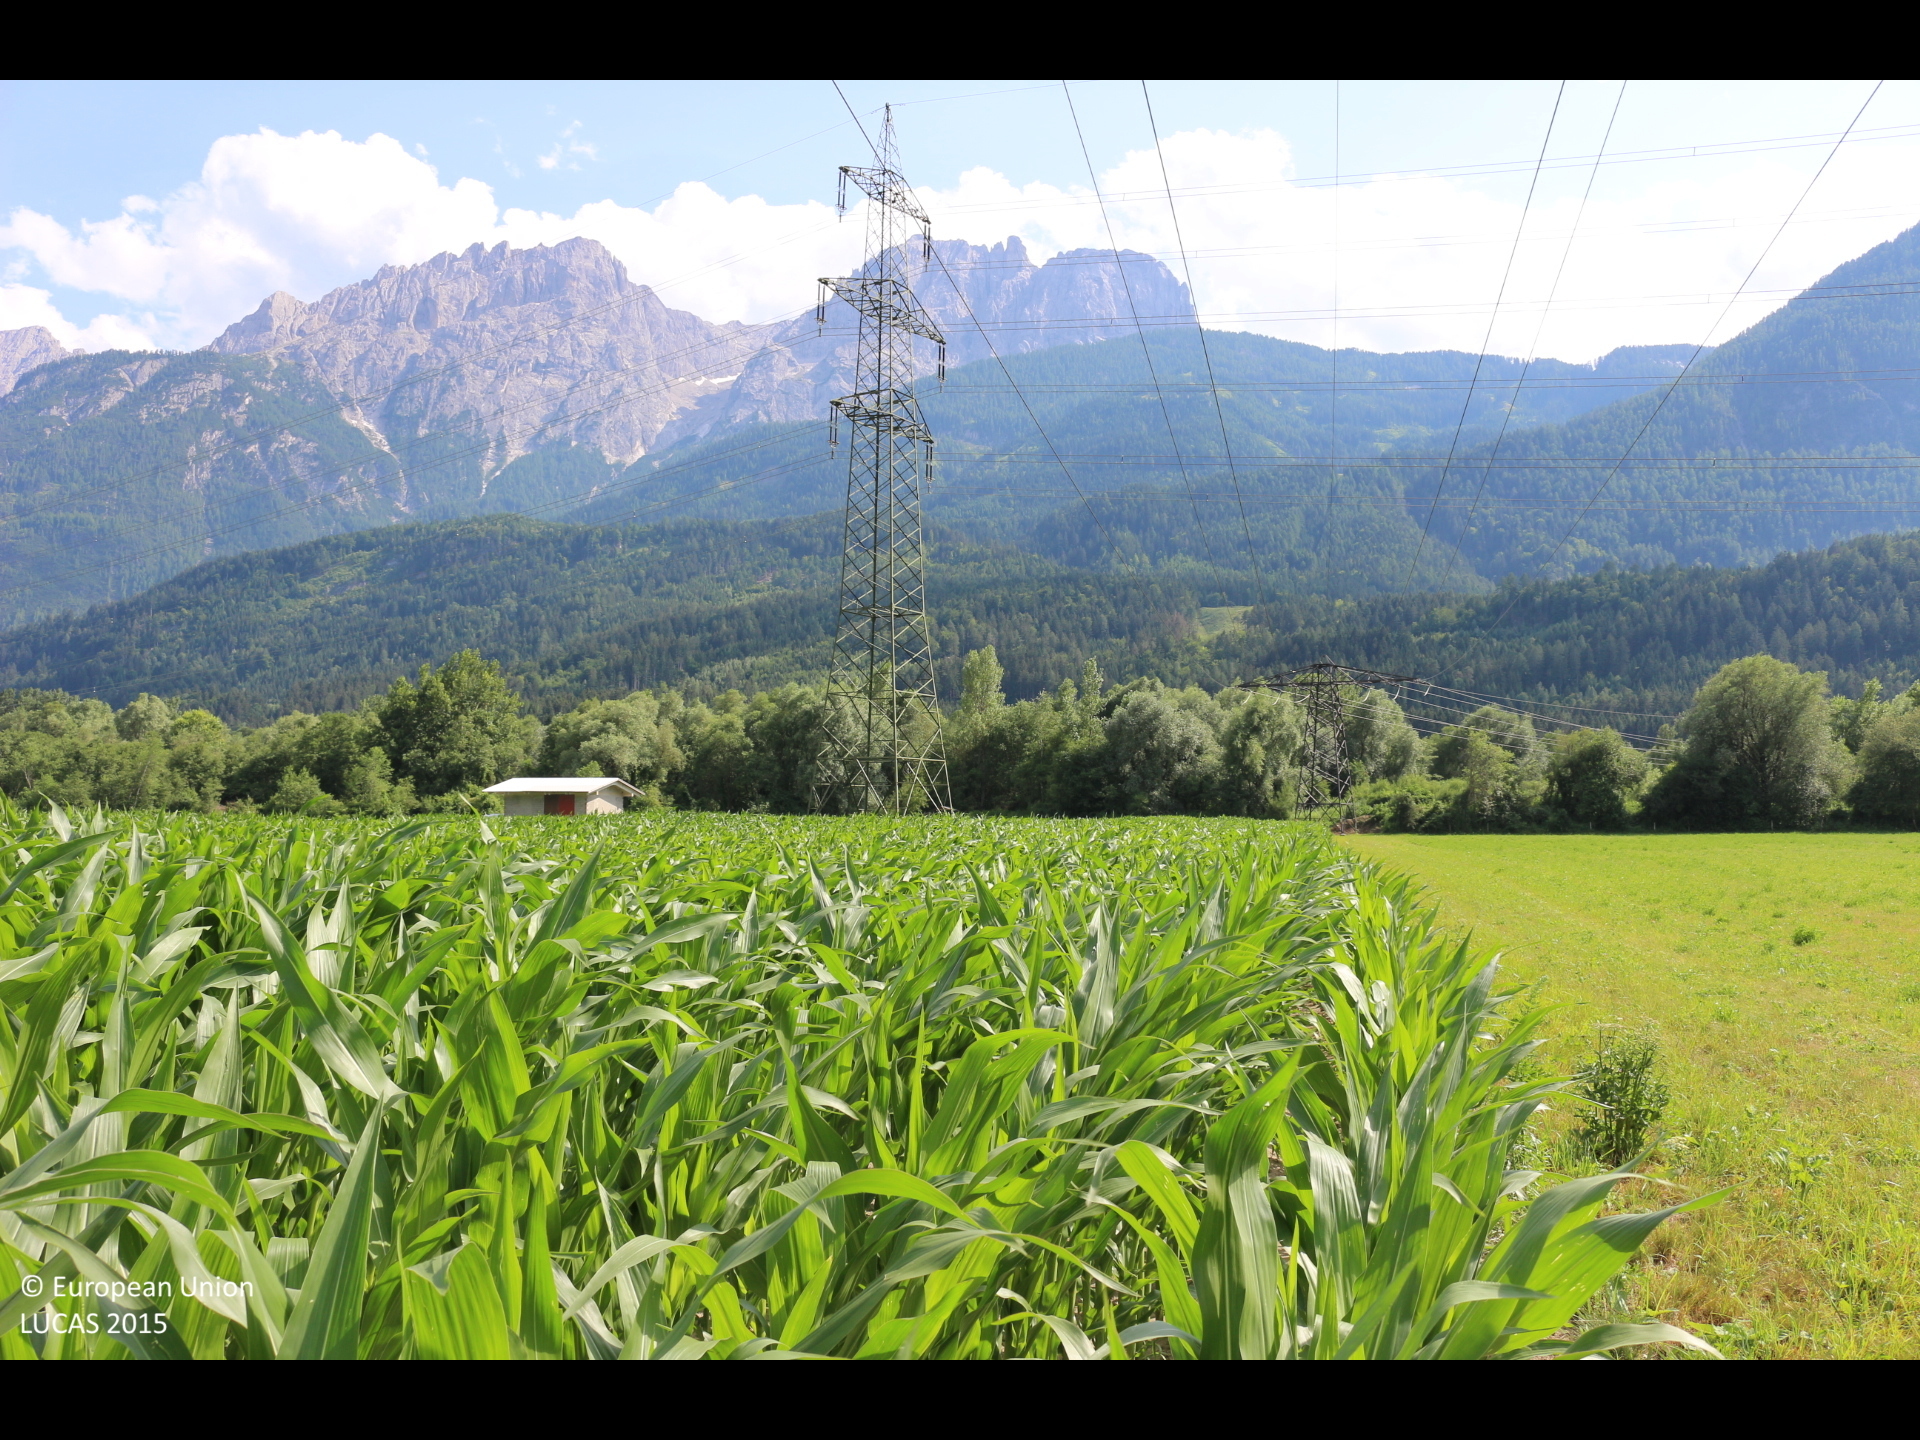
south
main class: Cropland
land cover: Maize
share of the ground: > 75 %
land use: Agriculture (excluding fallow land and kitchen gardens)
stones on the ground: < 10 %
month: July
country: AT
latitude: 46.8187
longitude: 12.8155
